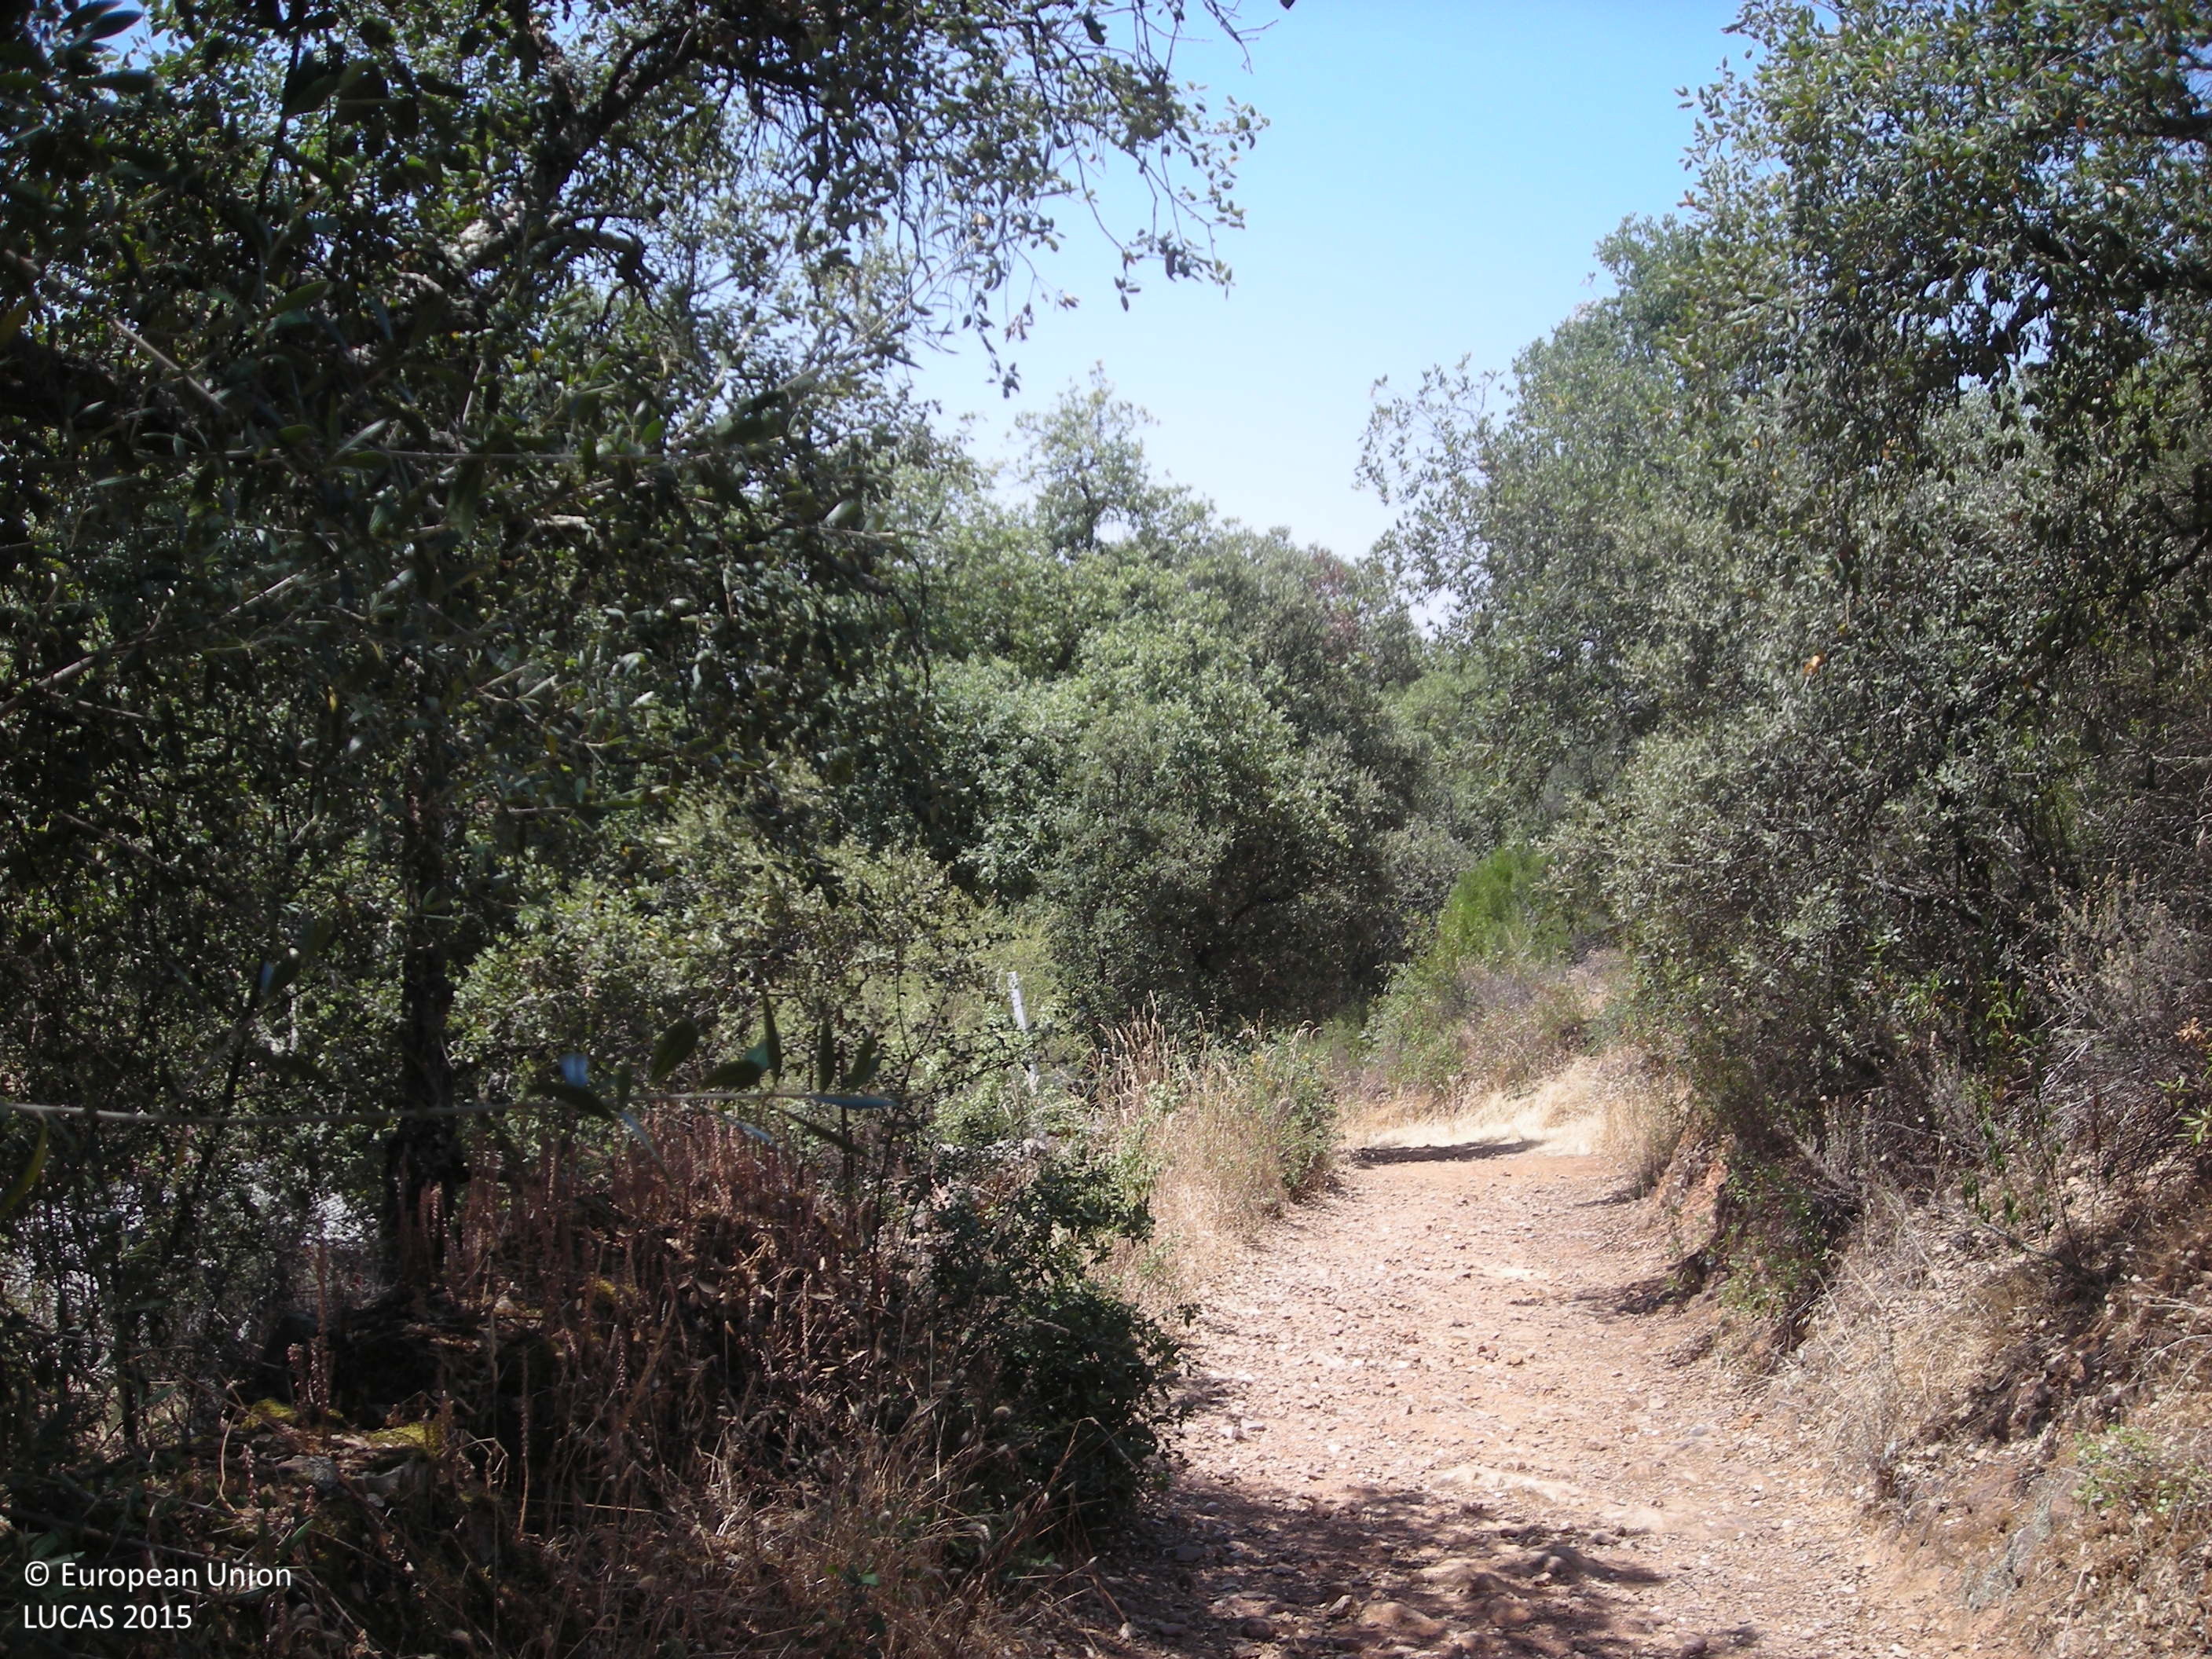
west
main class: Shrubland
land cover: Shrubland without tree cover
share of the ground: > 75 %
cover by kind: shrubs 100 %
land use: Semi-natural and natural areas not in use
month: June
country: ES
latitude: 39.0858
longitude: -5.4783
